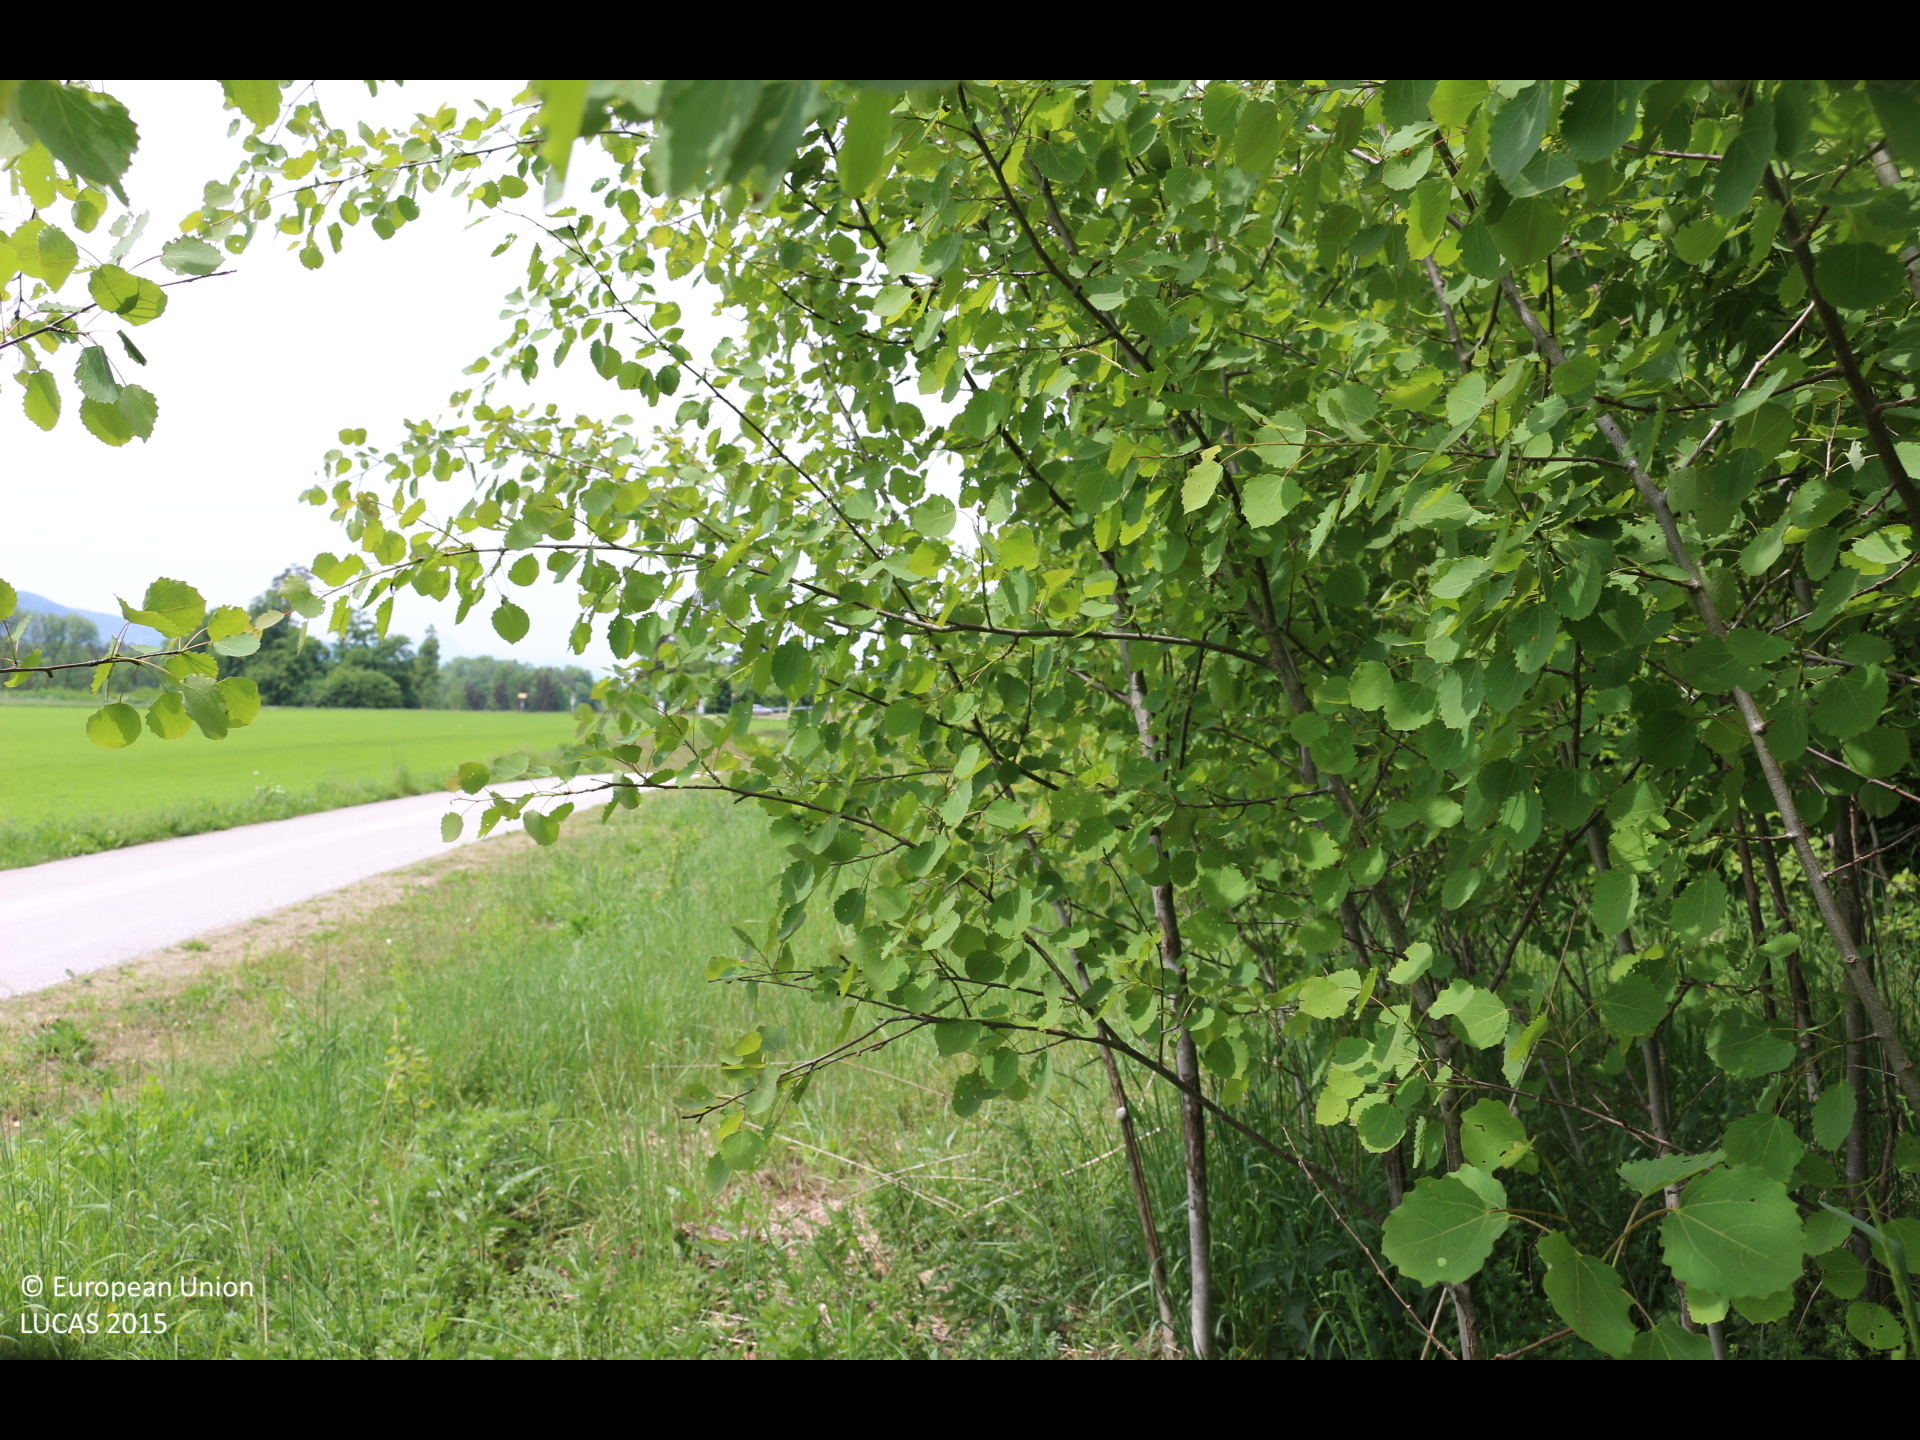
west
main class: Woodland
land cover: Broadleaved woodland
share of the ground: > 75 %
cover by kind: broadleaved forest trees 80 %, shrubs 10 %, herbaceous plants 10 %
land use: Railway transport
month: May
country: AT
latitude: 46.6204
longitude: 14.4246
